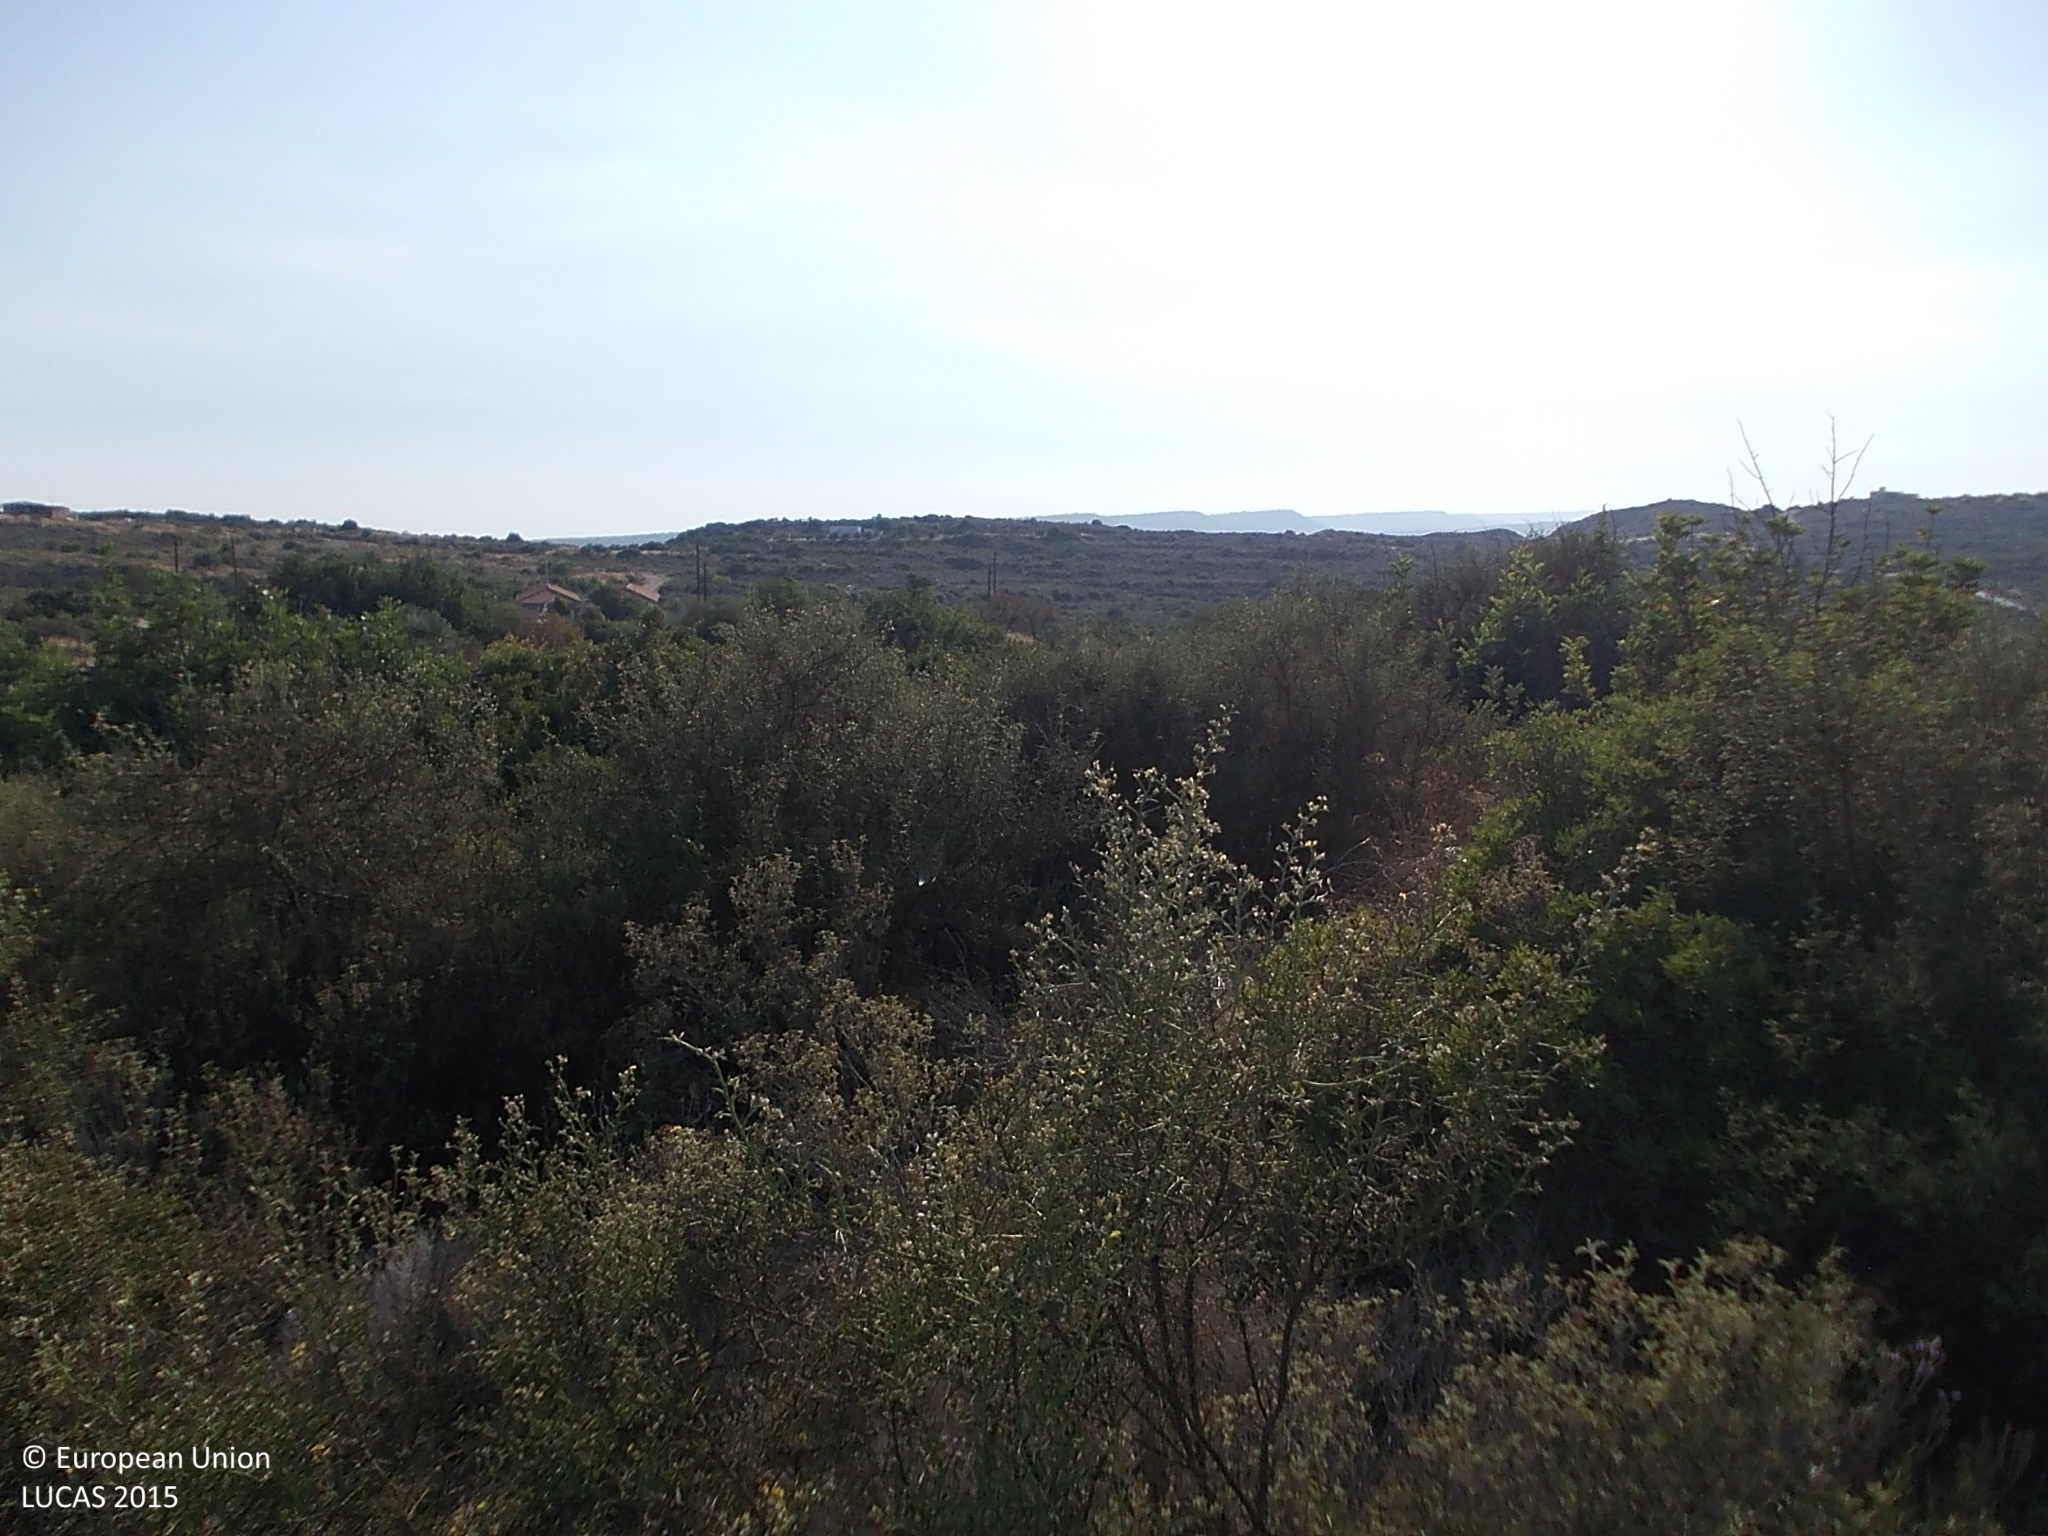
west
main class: Shrubland
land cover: Shrubland without tree cover
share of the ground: > 75 %
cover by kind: shrubs 90 %, unconsolidated bare surface 10 %
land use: Semi-natural and natural areas not in use
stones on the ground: 10 - 25 %
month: August
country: CY
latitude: 34.7543
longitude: 33.0084
